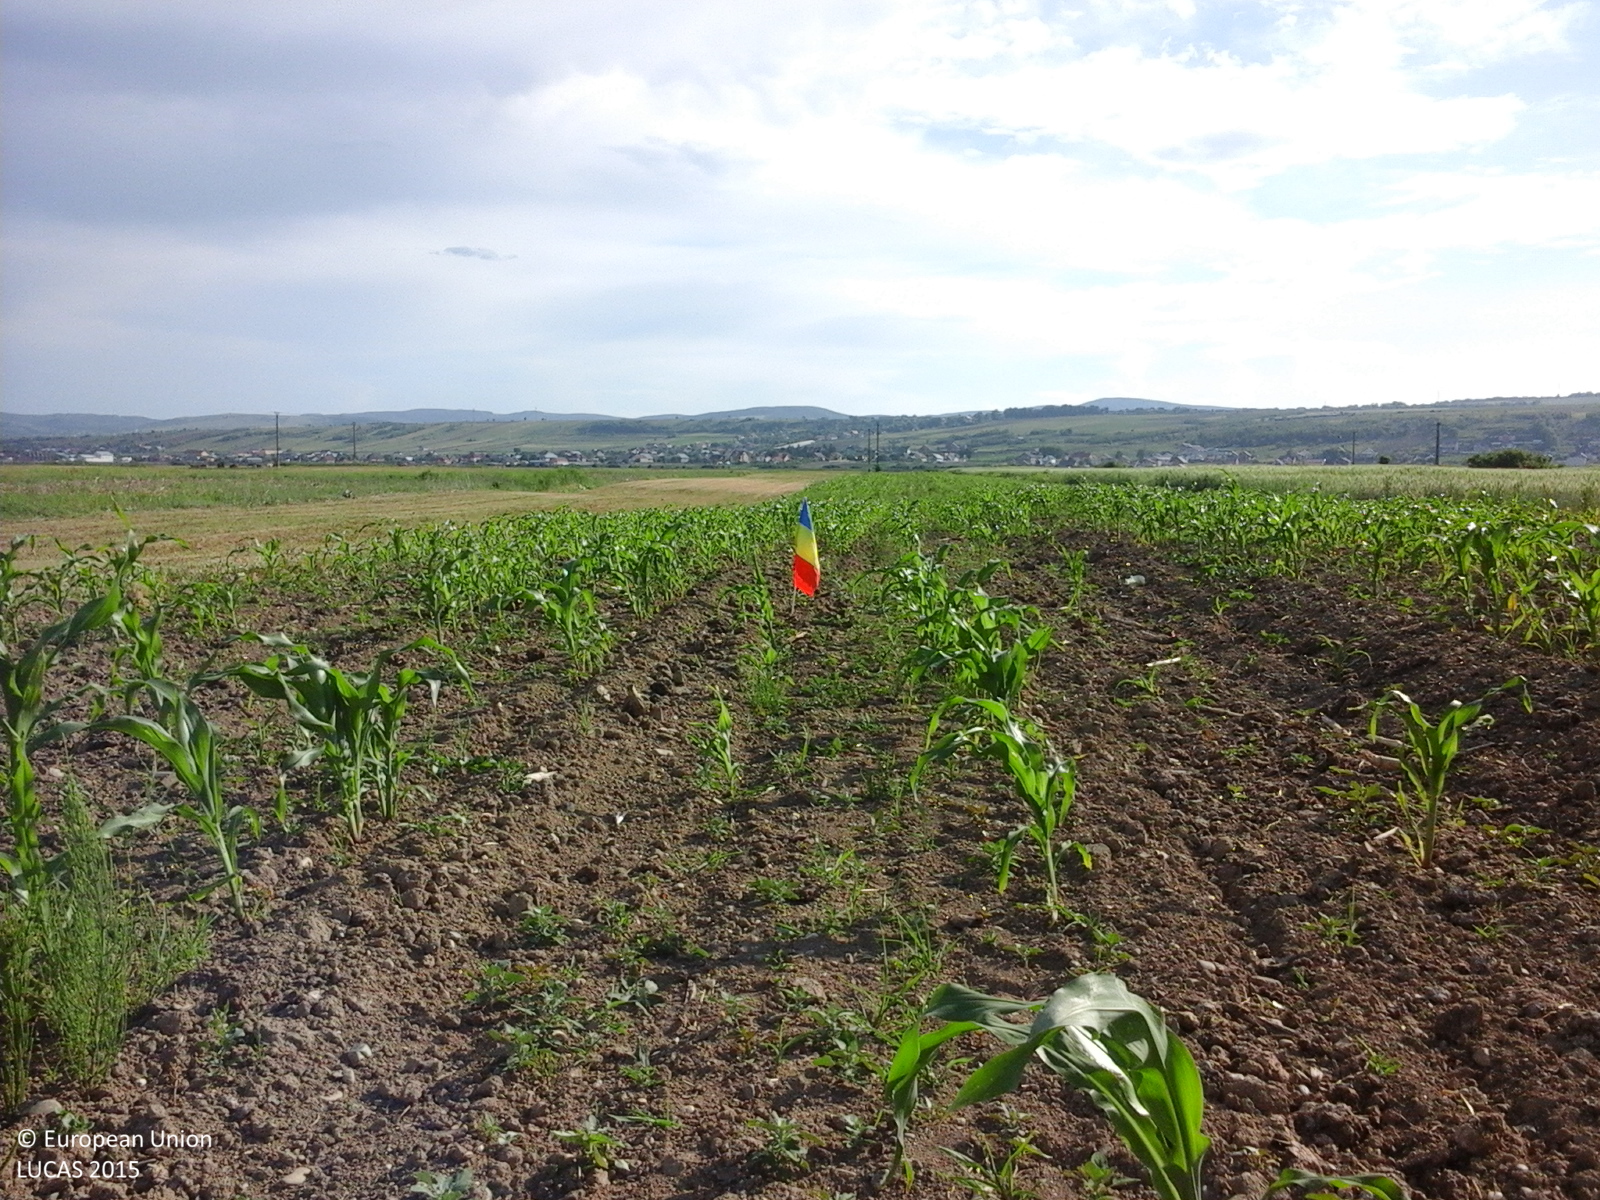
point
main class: Cropland
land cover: Maize
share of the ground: 10 - 25 %
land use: Agriculture (excluding fallow land and kitchen gardens)
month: June
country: RO
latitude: 46.6162
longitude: 26.8728
